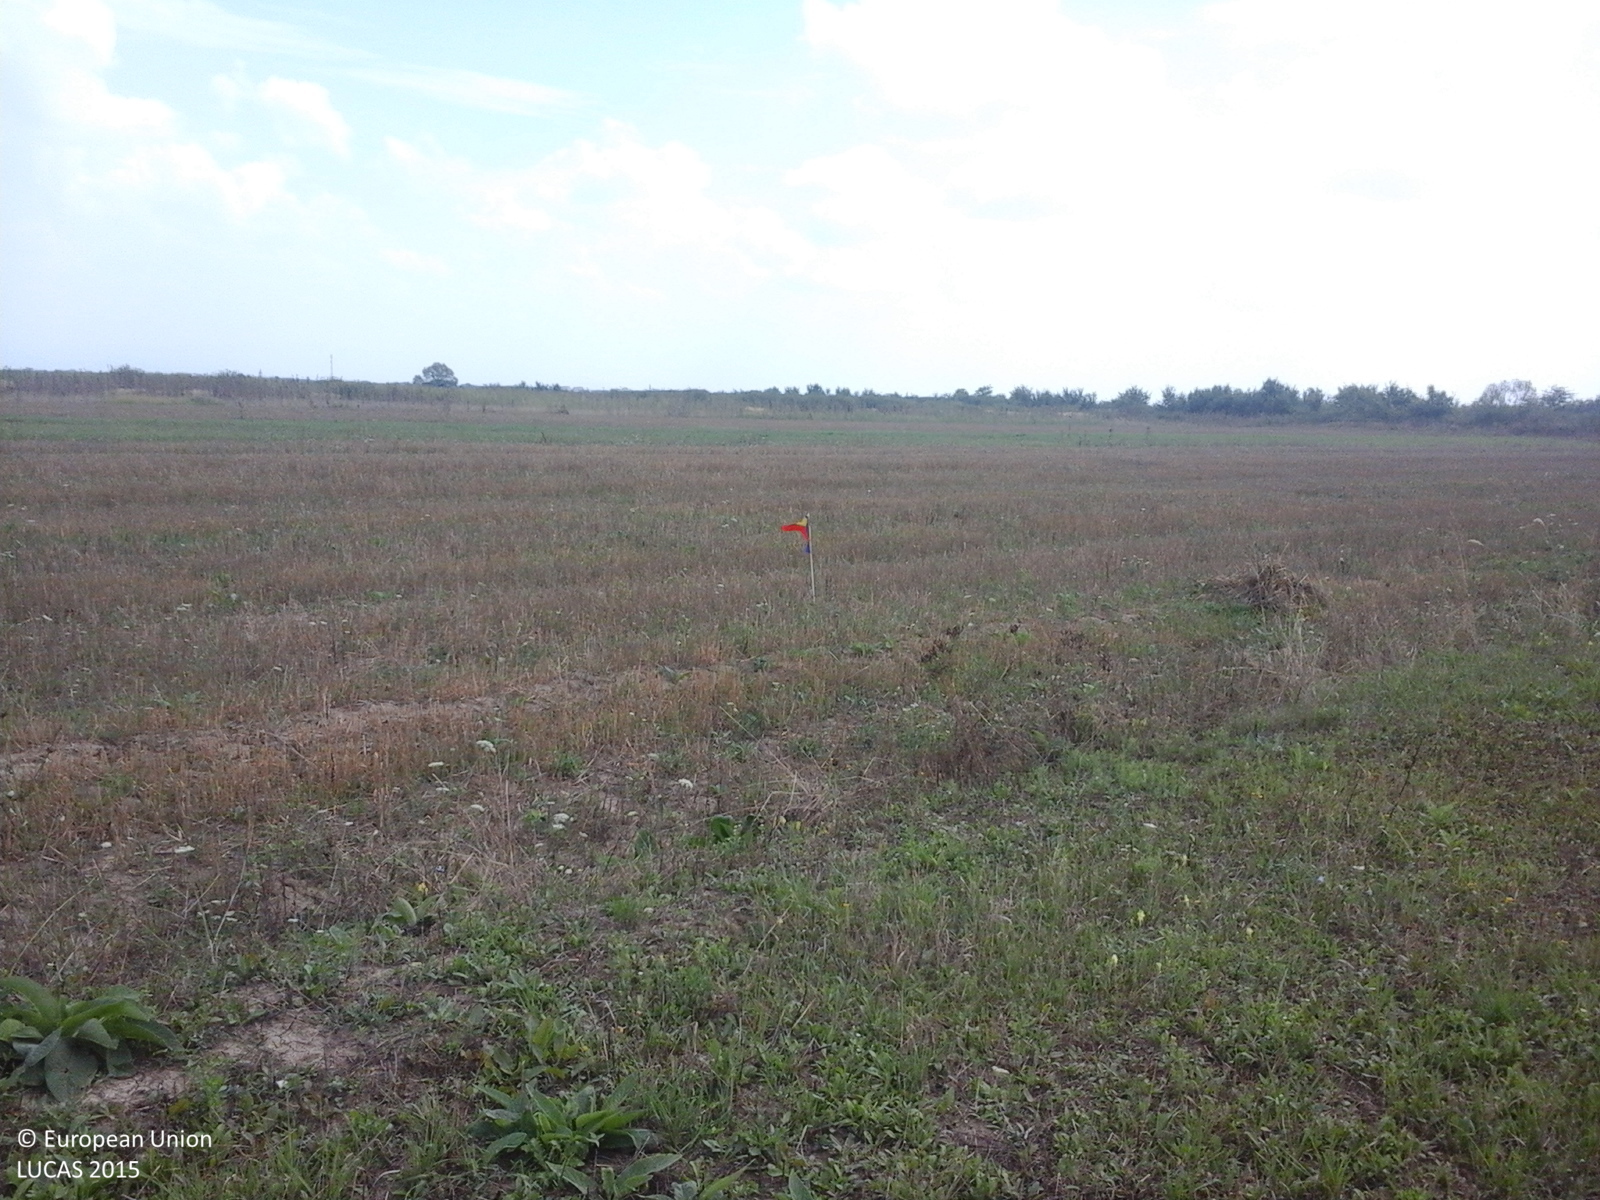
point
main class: Cropland
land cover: Common wheat
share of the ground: 50 - 75 %
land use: Agriculture (excluding fallow land and kitchen gardens)
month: August
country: RO
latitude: 46.6309
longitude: 21.7316
